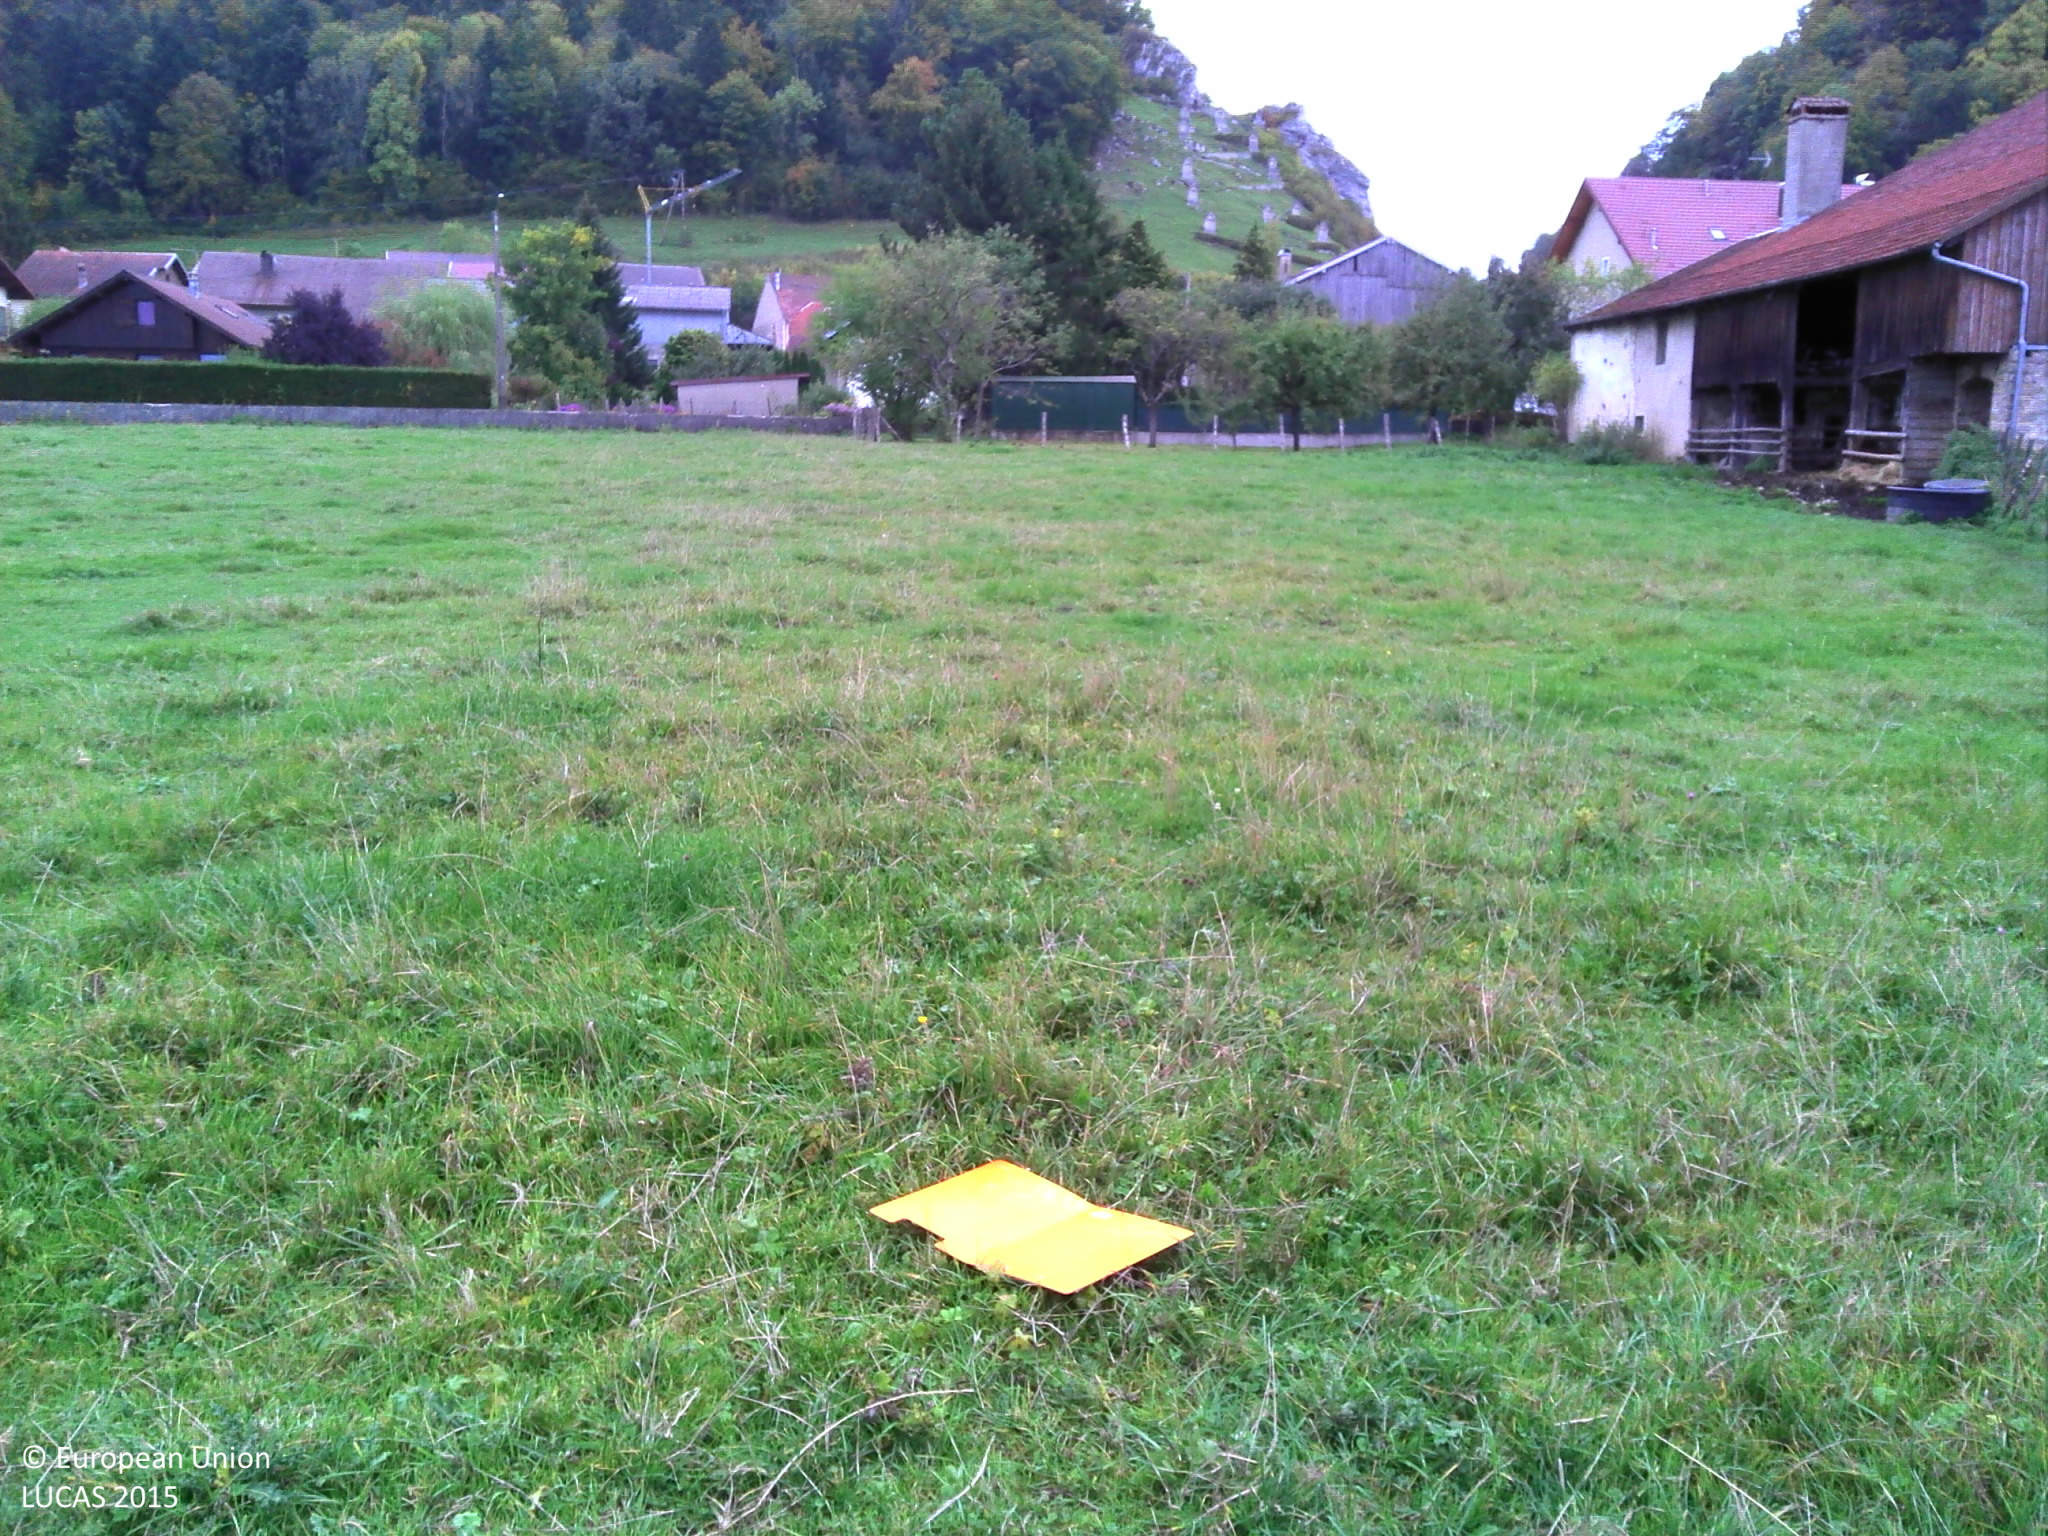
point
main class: Grassland
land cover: Grassland without tree/shrub cover
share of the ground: > 75 %
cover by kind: herbaceous plants 100 %
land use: Agriculture (excluding fallow land and kitchen gardens)
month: October
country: FR
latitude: 46.9528
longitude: 6.2575
